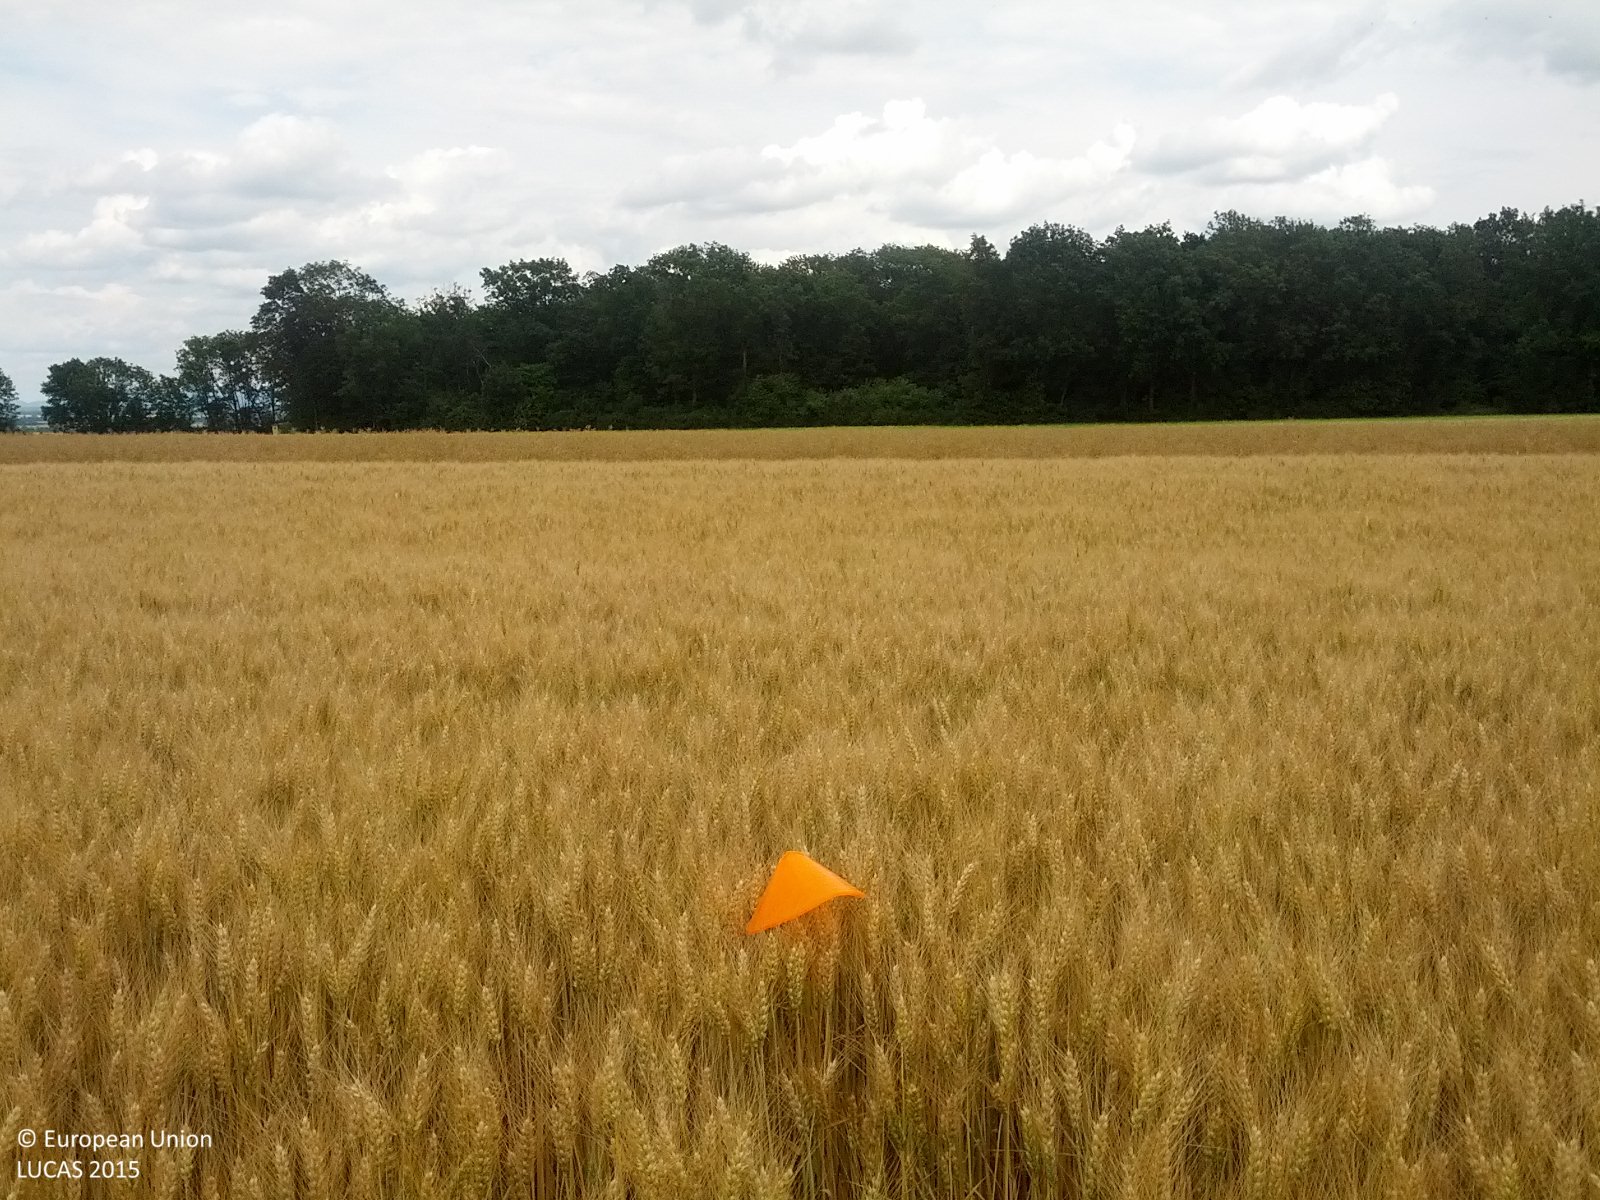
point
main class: Cropland
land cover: Common wheat
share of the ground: > 75 %
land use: Agriculture (excluding fallow land and kitchen gardens)
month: June
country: AT
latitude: 48.4285
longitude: 16.8050
